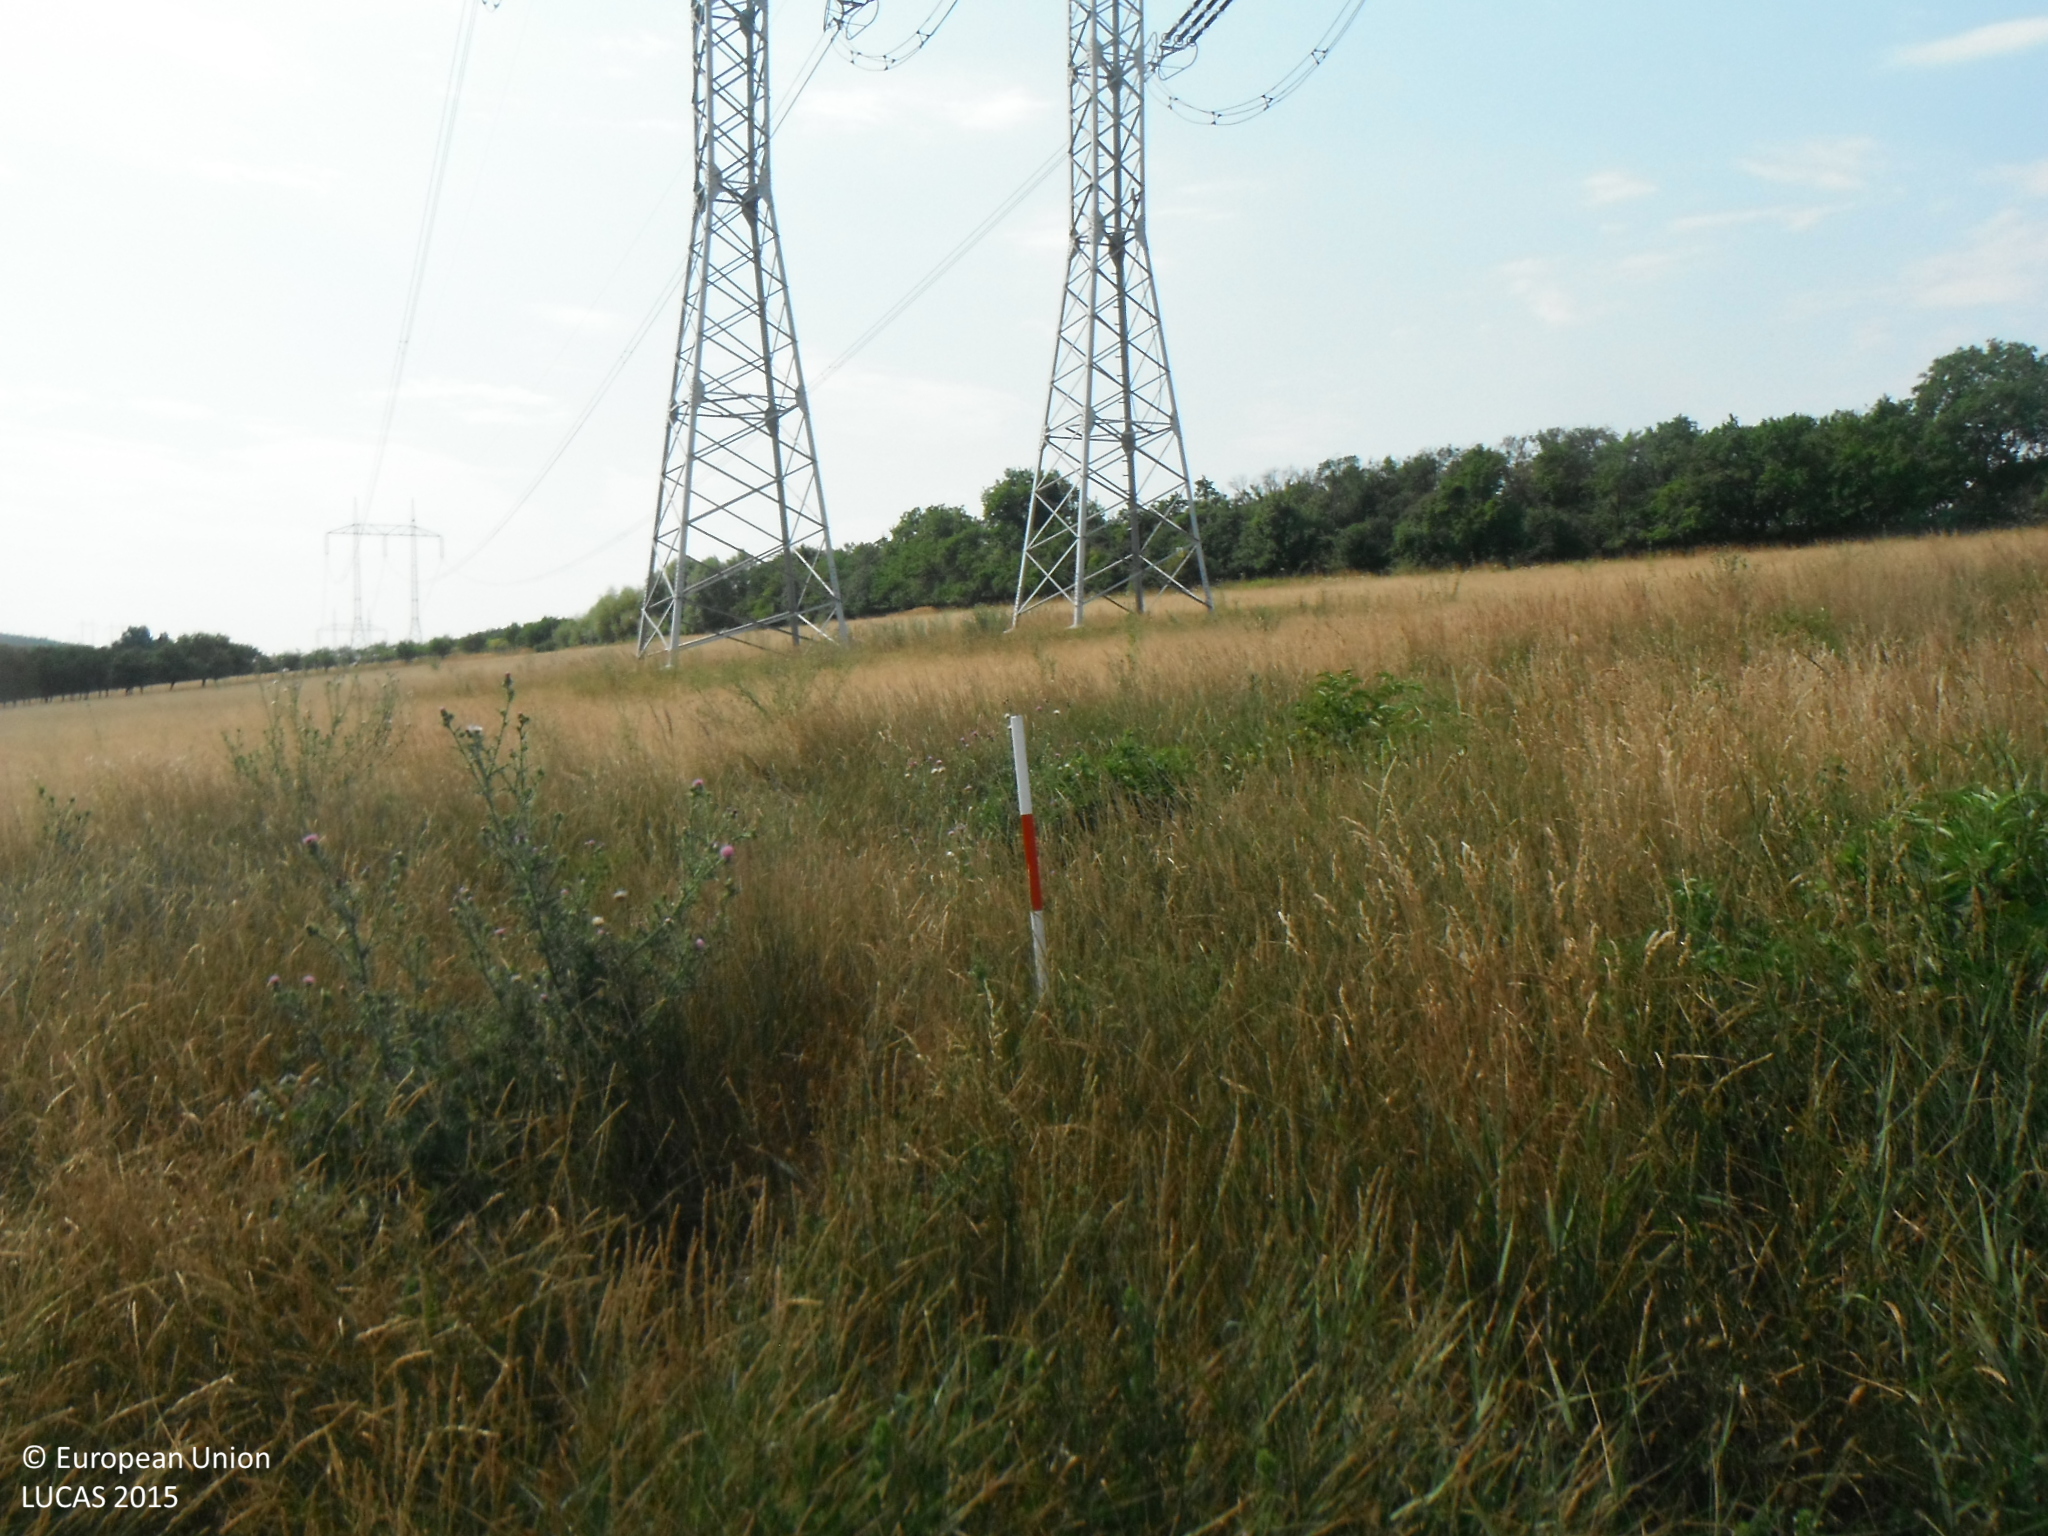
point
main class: Grassland
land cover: Spontaneously vegetated surfaces
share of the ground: > 75 %
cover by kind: herbaceous plants 95 %, shrubs 5 %
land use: Semi-natural and natural areas not in use
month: July
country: SK
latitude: 48.8323
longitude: 17.2711
